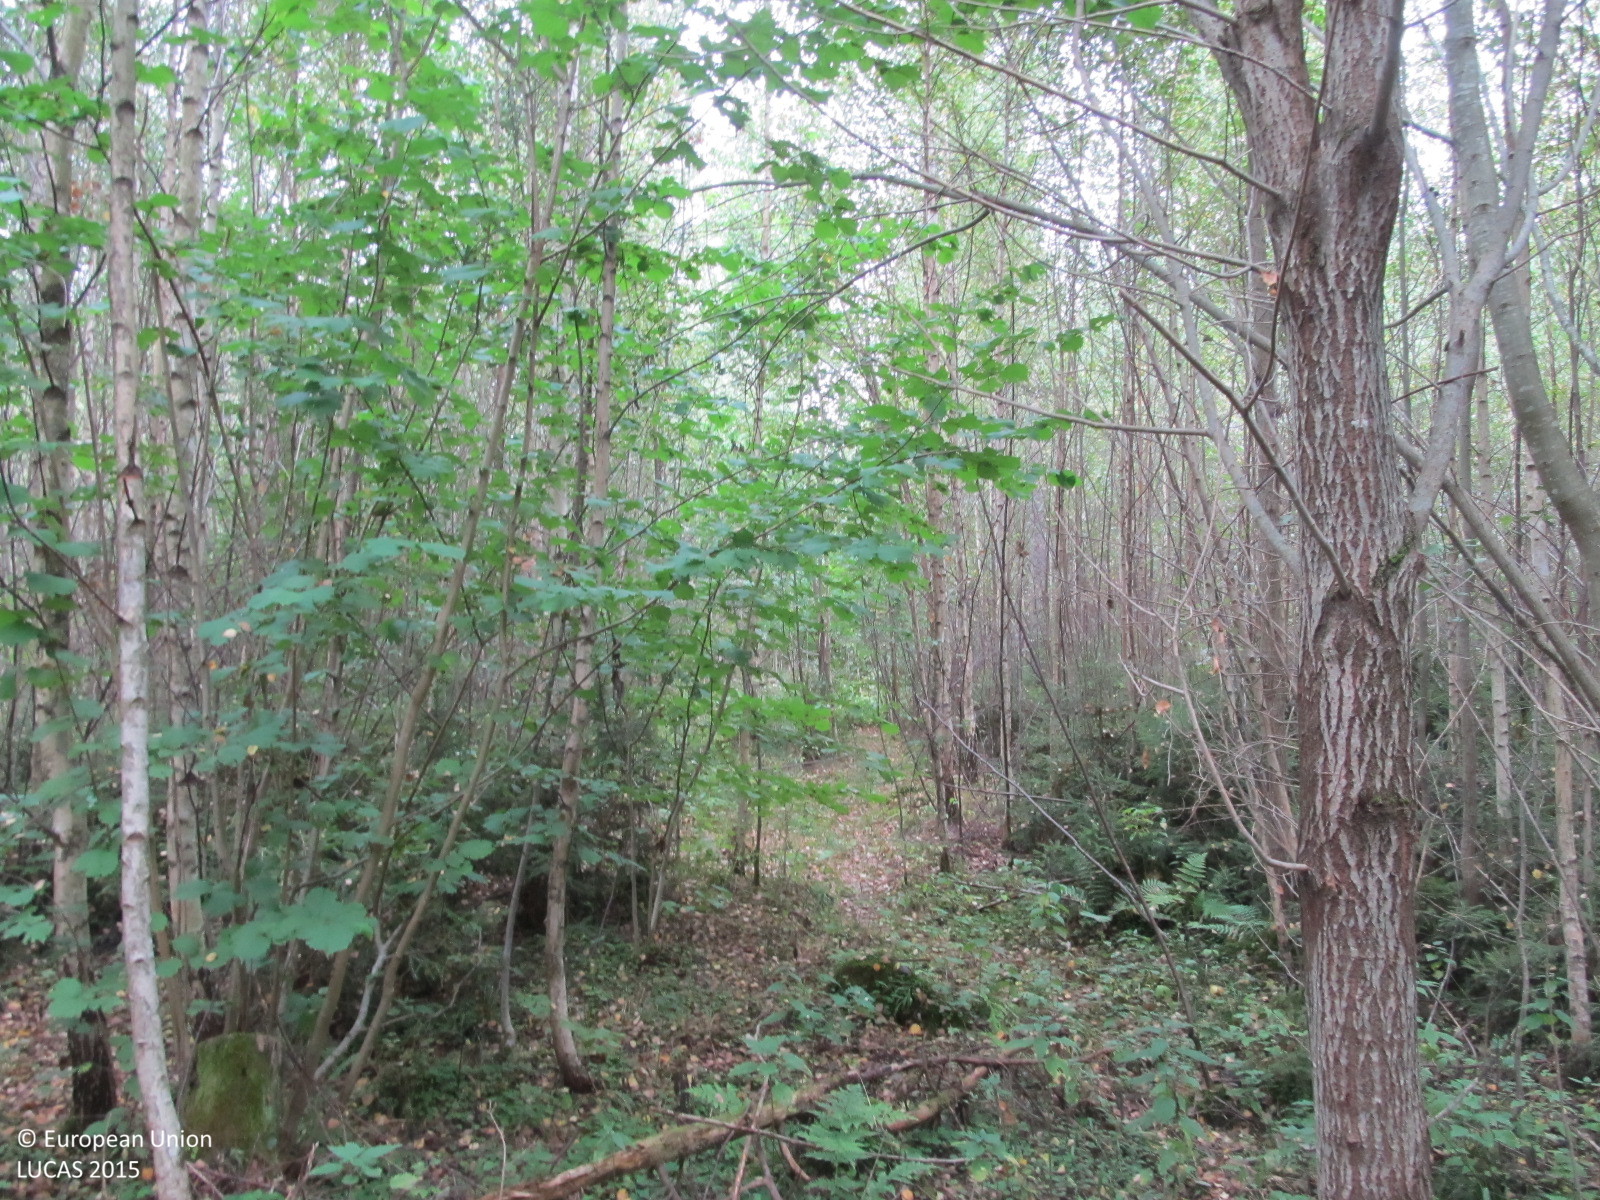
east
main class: Woodland
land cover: Broadleaved woodland
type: non-riverine alder, birch or aspen forest
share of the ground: > 75 %
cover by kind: broadleaved forest trees 70 %, coniferous forest trees 10 %, herbaceous plants 10 %, shrubs 5 %, unconsolidated bare surface 5 %
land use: Forestry
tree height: > 5 m
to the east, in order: Broadleaved woodland; Spruce dominated mixed woodland; Shrubland with sparse tree cover; Grassland with sparse tree/shrub cover; Spruce dominated coniferous woodland
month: September
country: LT
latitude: 56.0502
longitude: 22.4695
